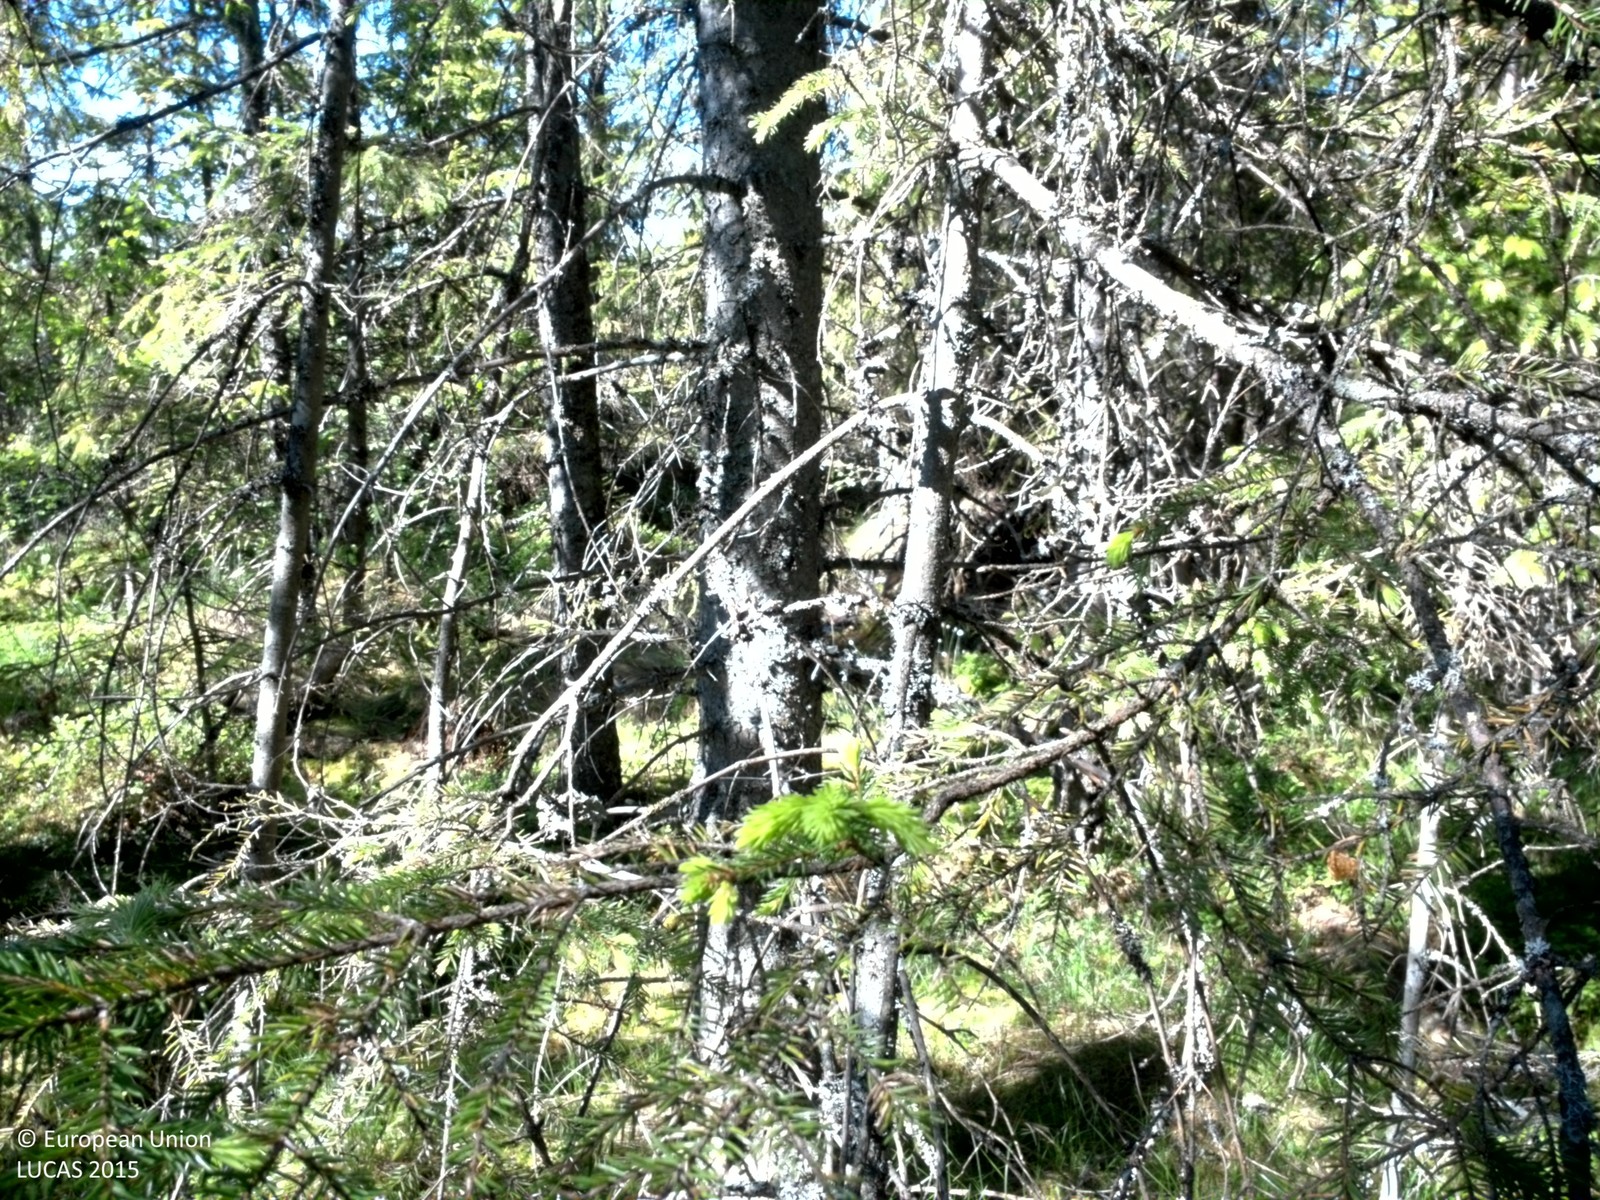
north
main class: Woodland
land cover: Spruce dominated coniferous woodland
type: boreal forest
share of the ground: 50 - 75 %
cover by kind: coniferous forest trees 65 %, shrubs 15 %, herbaceous plants 10 %, broadleaved forest trees 5 %, lichens and mosses 5 %
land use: Forestry
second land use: Community services
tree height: > 5 m
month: June
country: SE
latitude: 59.3096
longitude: 14.6814
